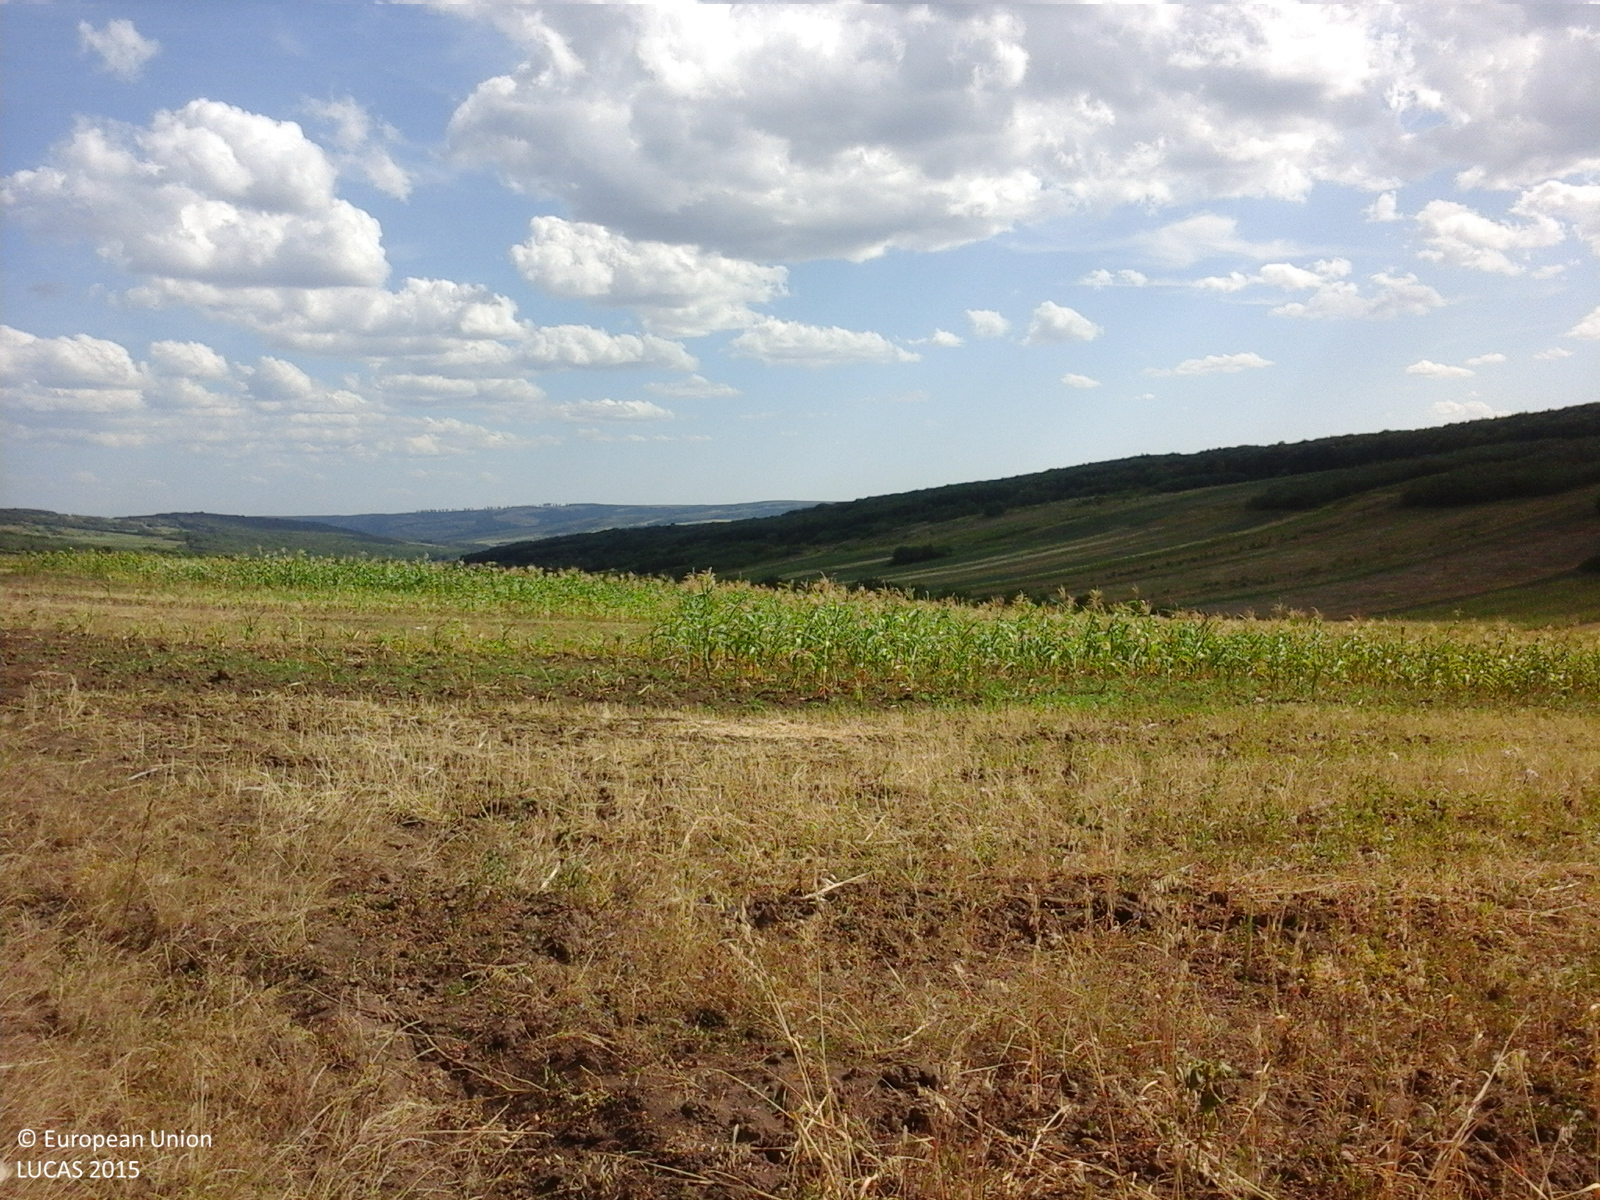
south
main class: Woodland
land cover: Broadleaved woodland
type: acidophilous oak and oak-birch forest
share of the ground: > 75 %
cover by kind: broadleaved forest trees 100 %
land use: Forestry
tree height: > 5 m
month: July
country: RO
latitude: 46.2093
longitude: 27.8905
